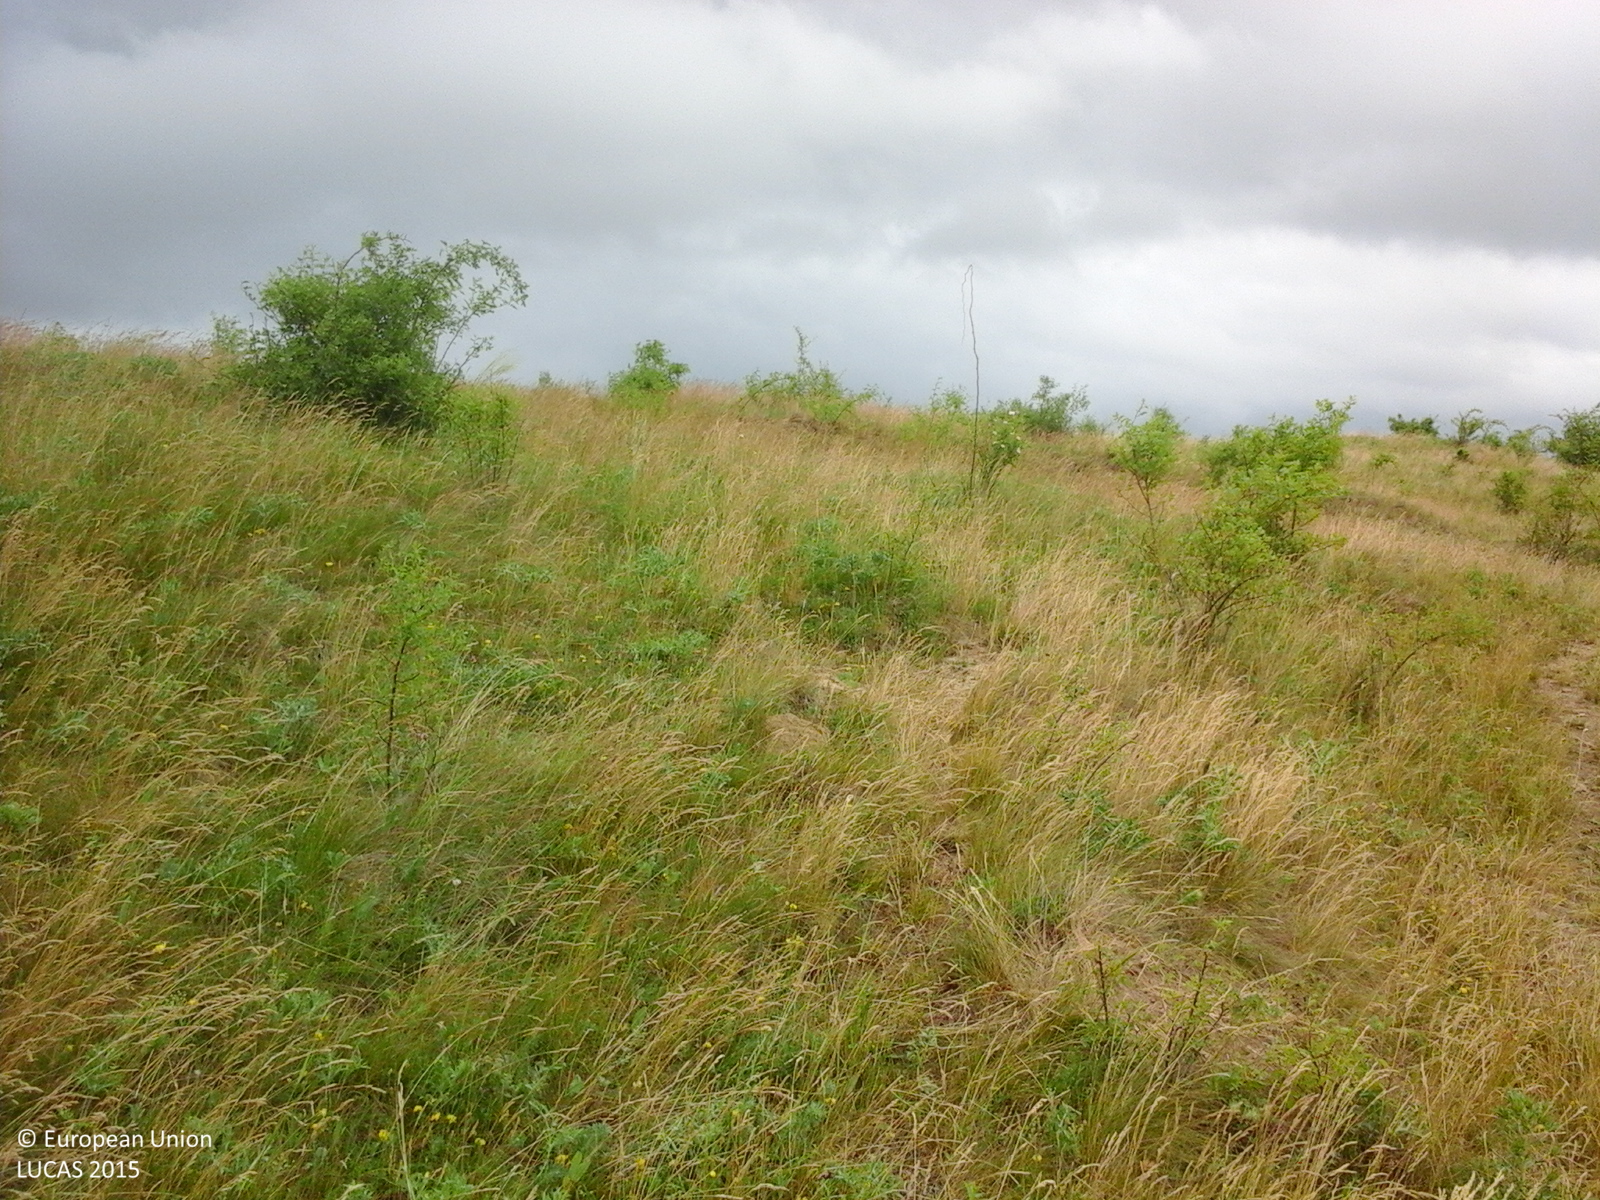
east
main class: Grassland
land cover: Grassland with sparse tree/shrub cover
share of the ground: > 75 %
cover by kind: herbaceous plants 85 %, shrubs 10 %, broadleaved forest trees 5 %
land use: Agriculture (excluding fallow land and kitchen gardens)
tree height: < 5 m
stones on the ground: < 10 %
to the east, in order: Grassland with sparse tree/shrub cover; Grassland without tree/shrub cover; Ditches and canals; Grassland without tree/shrub cover; Tracks; Grassland without tree/shrub cover; Tracks; Grassland without tree/shrub cover; Fences; Grass margins; Oats
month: June
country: RO
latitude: 47.1871
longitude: 26.2736
